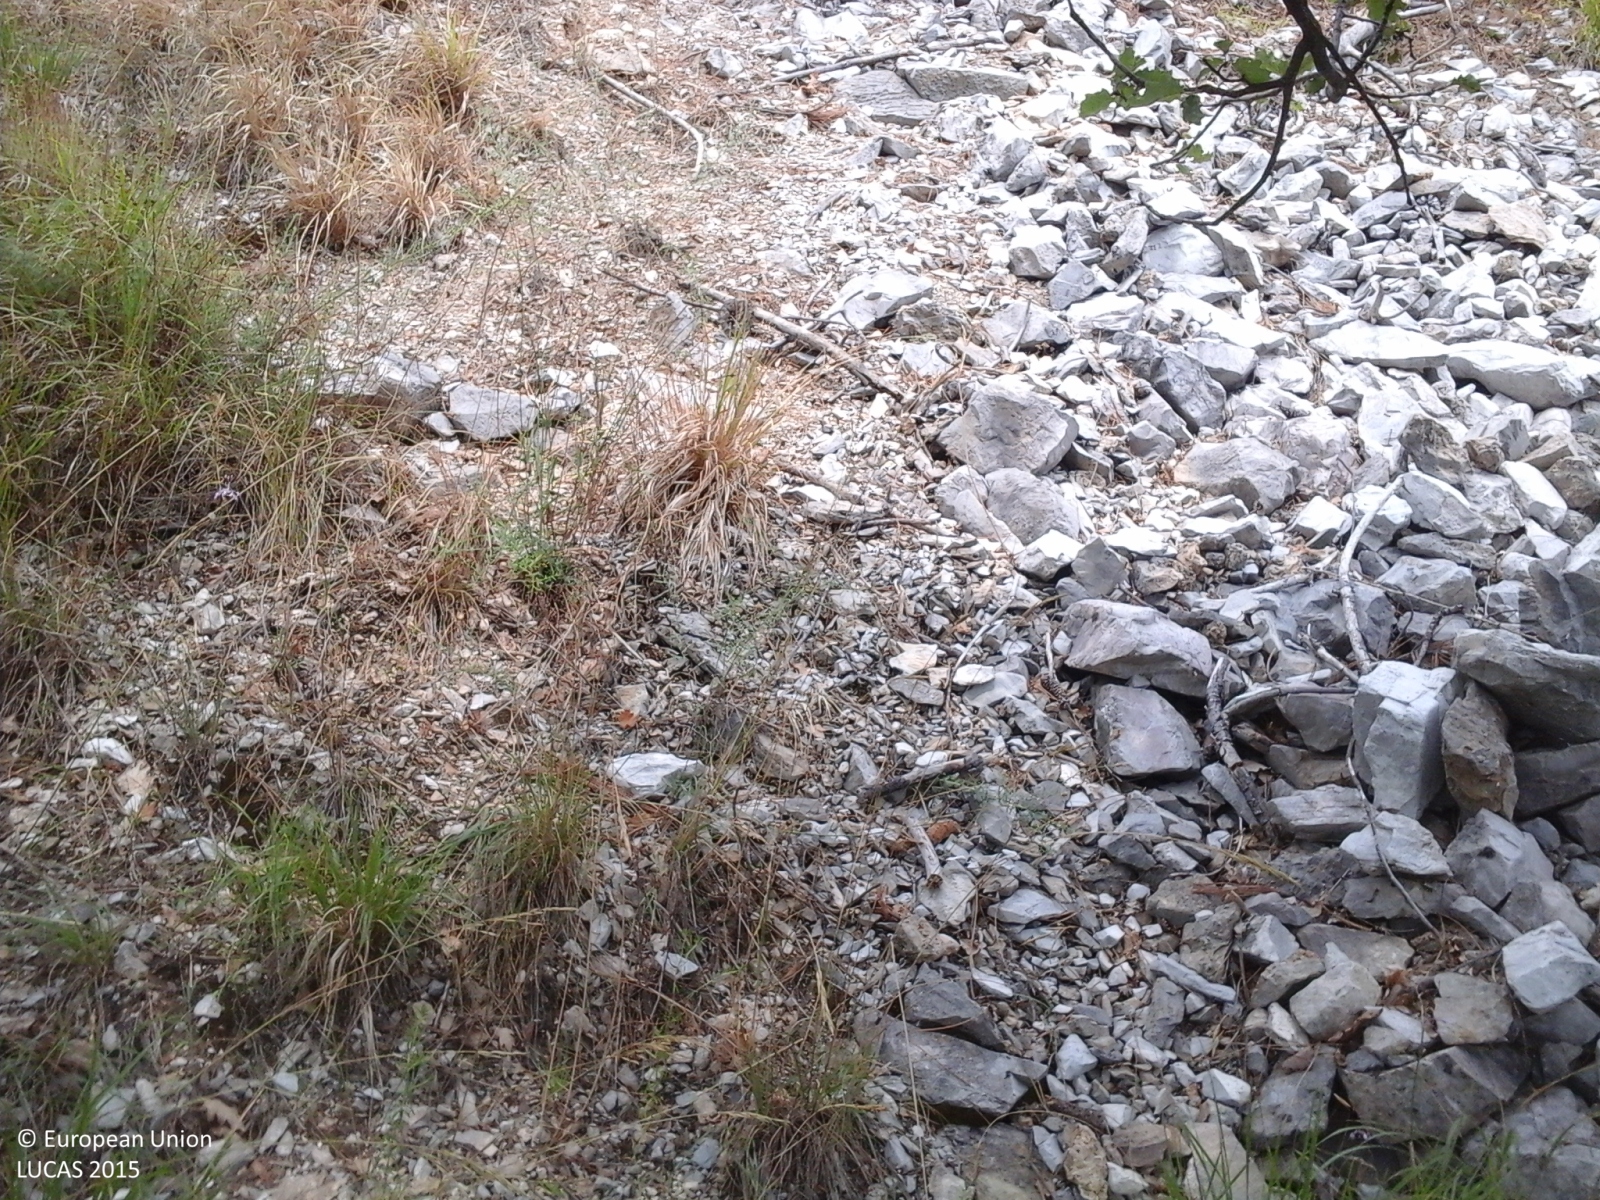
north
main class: Woodland
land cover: Other mixed woodland
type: thermophilous deciduous forest
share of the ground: > 75 %
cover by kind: broadleaved forest trees 50 %, unconsolidated bare surface 30 %, coniferous forest trees 20 %
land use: Forestry
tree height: > 5 m
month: August
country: IT
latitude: 44.0798
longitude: 10.1868
